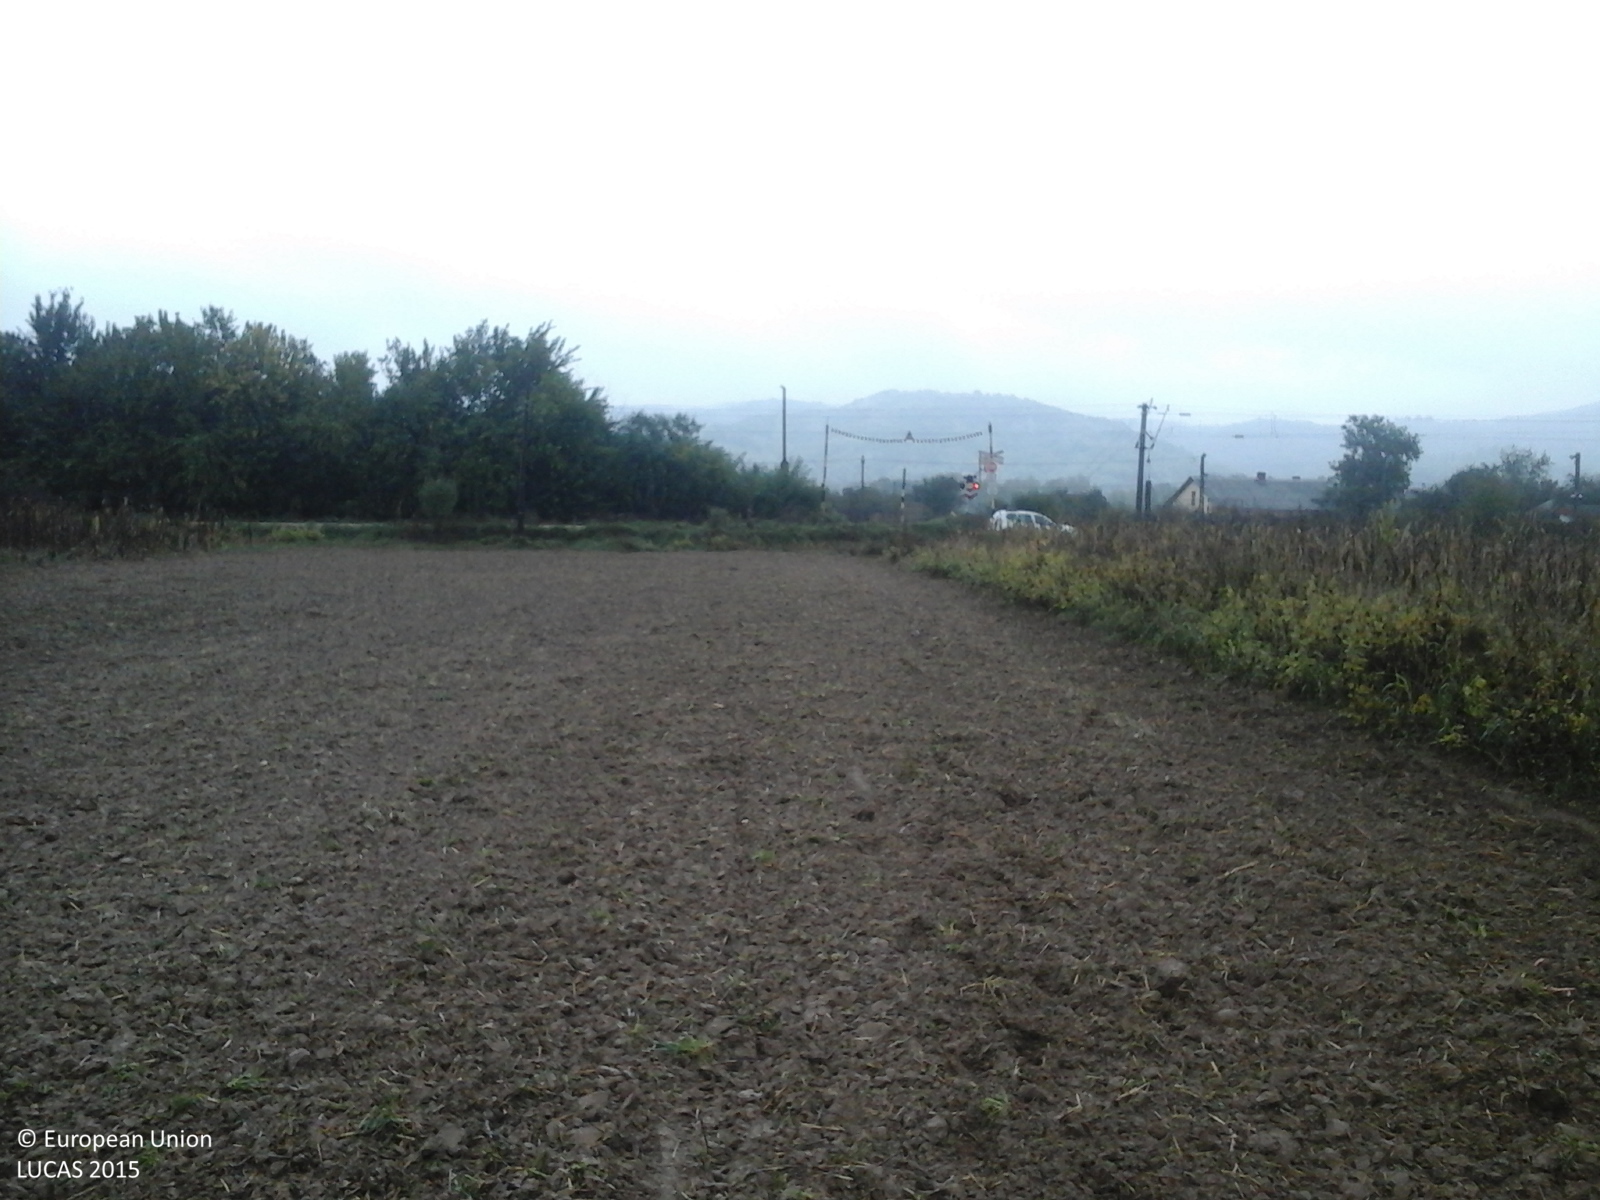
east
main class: Cropland
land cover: Common wheat
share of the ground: < 10 %
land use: Agriculture (excluding fallow land and kitchen gardens)
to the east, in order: Common wheat; Spontaneously vegetated surfaces; Tracks; Railways; Tracks; Fences; Grassland without tree/shrub cover; Fences; Tracks; Broadleaved woodland; Artificial constructions; Tracks; Lucerne
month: September
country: RO
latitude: 44.8686
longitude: 23.5108
